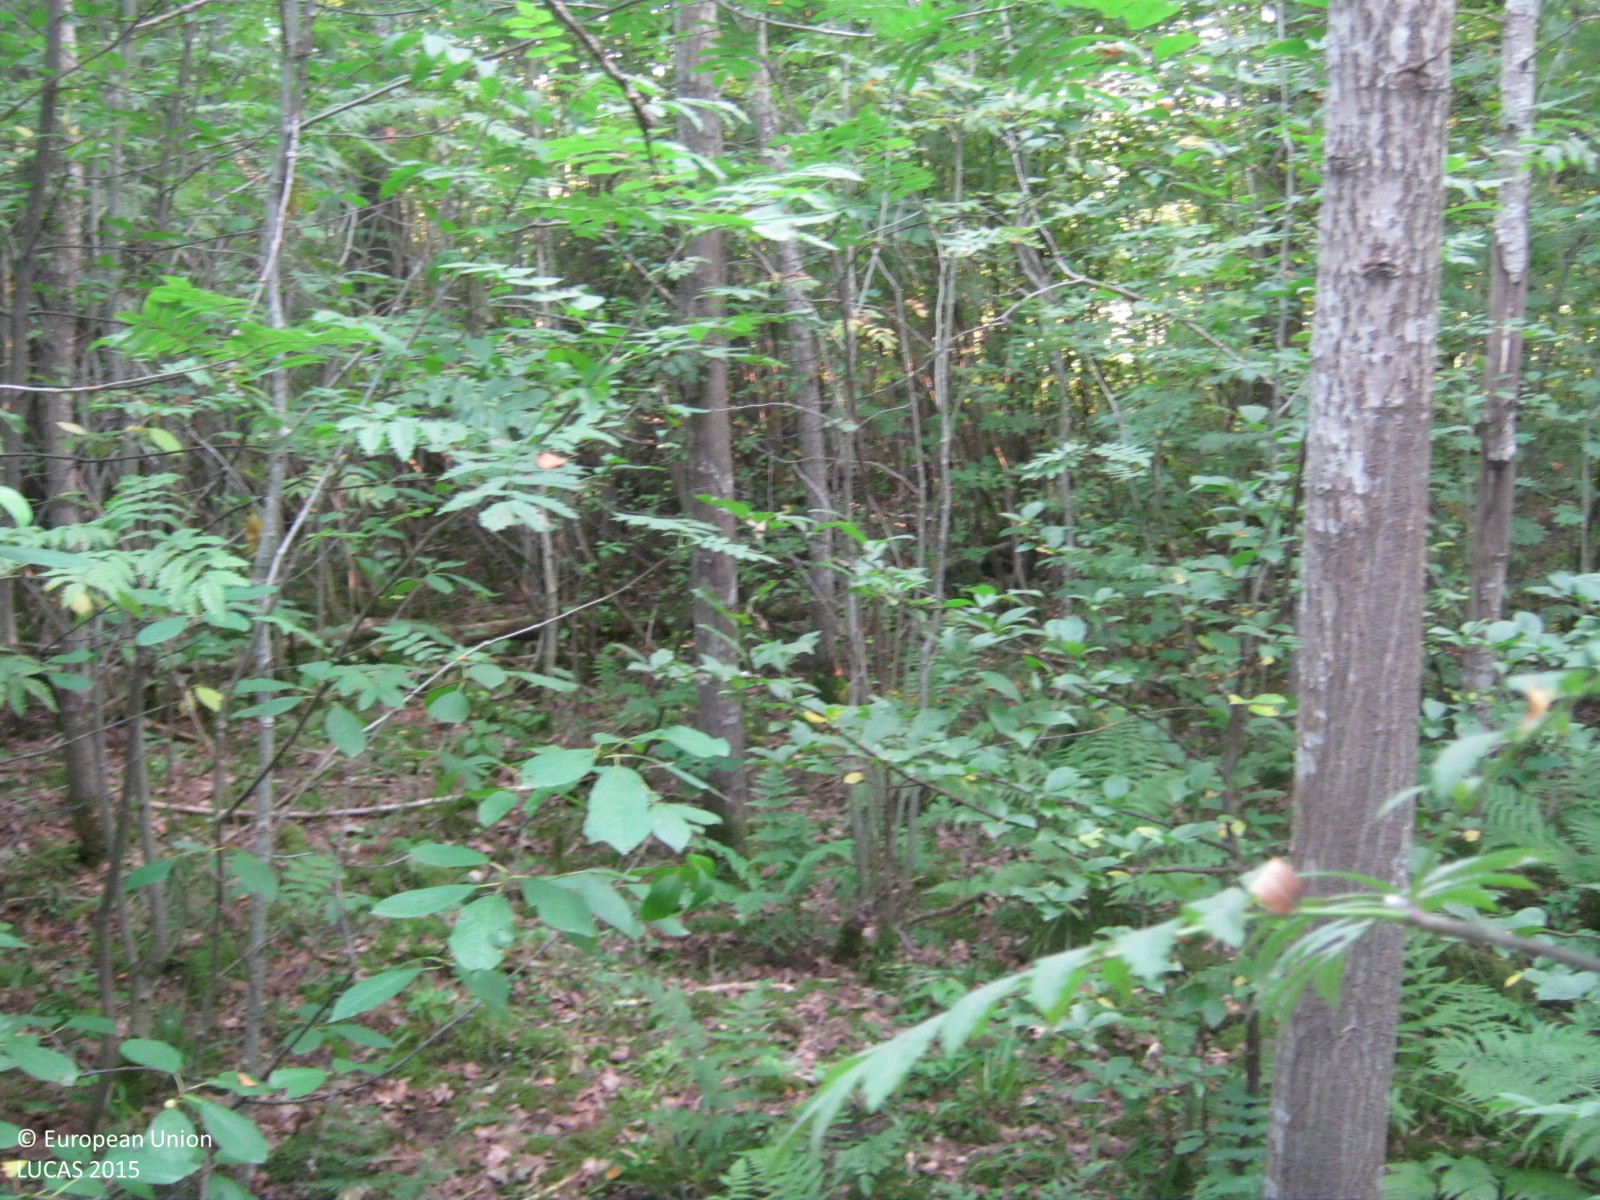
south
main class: Woodland
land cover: Broadleaved woodland
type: non-riverine alder, birch or aspen forest
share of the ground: > 75 %
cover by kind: broadleaved forest trees 80 %, coniferous forest trees 10 %, herbaceous plants 5 %, unconsolidated bare surface 5 %
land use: Forestry
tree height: > 5 m
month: August
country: LV
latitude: 57.3916
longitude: 24.6533
